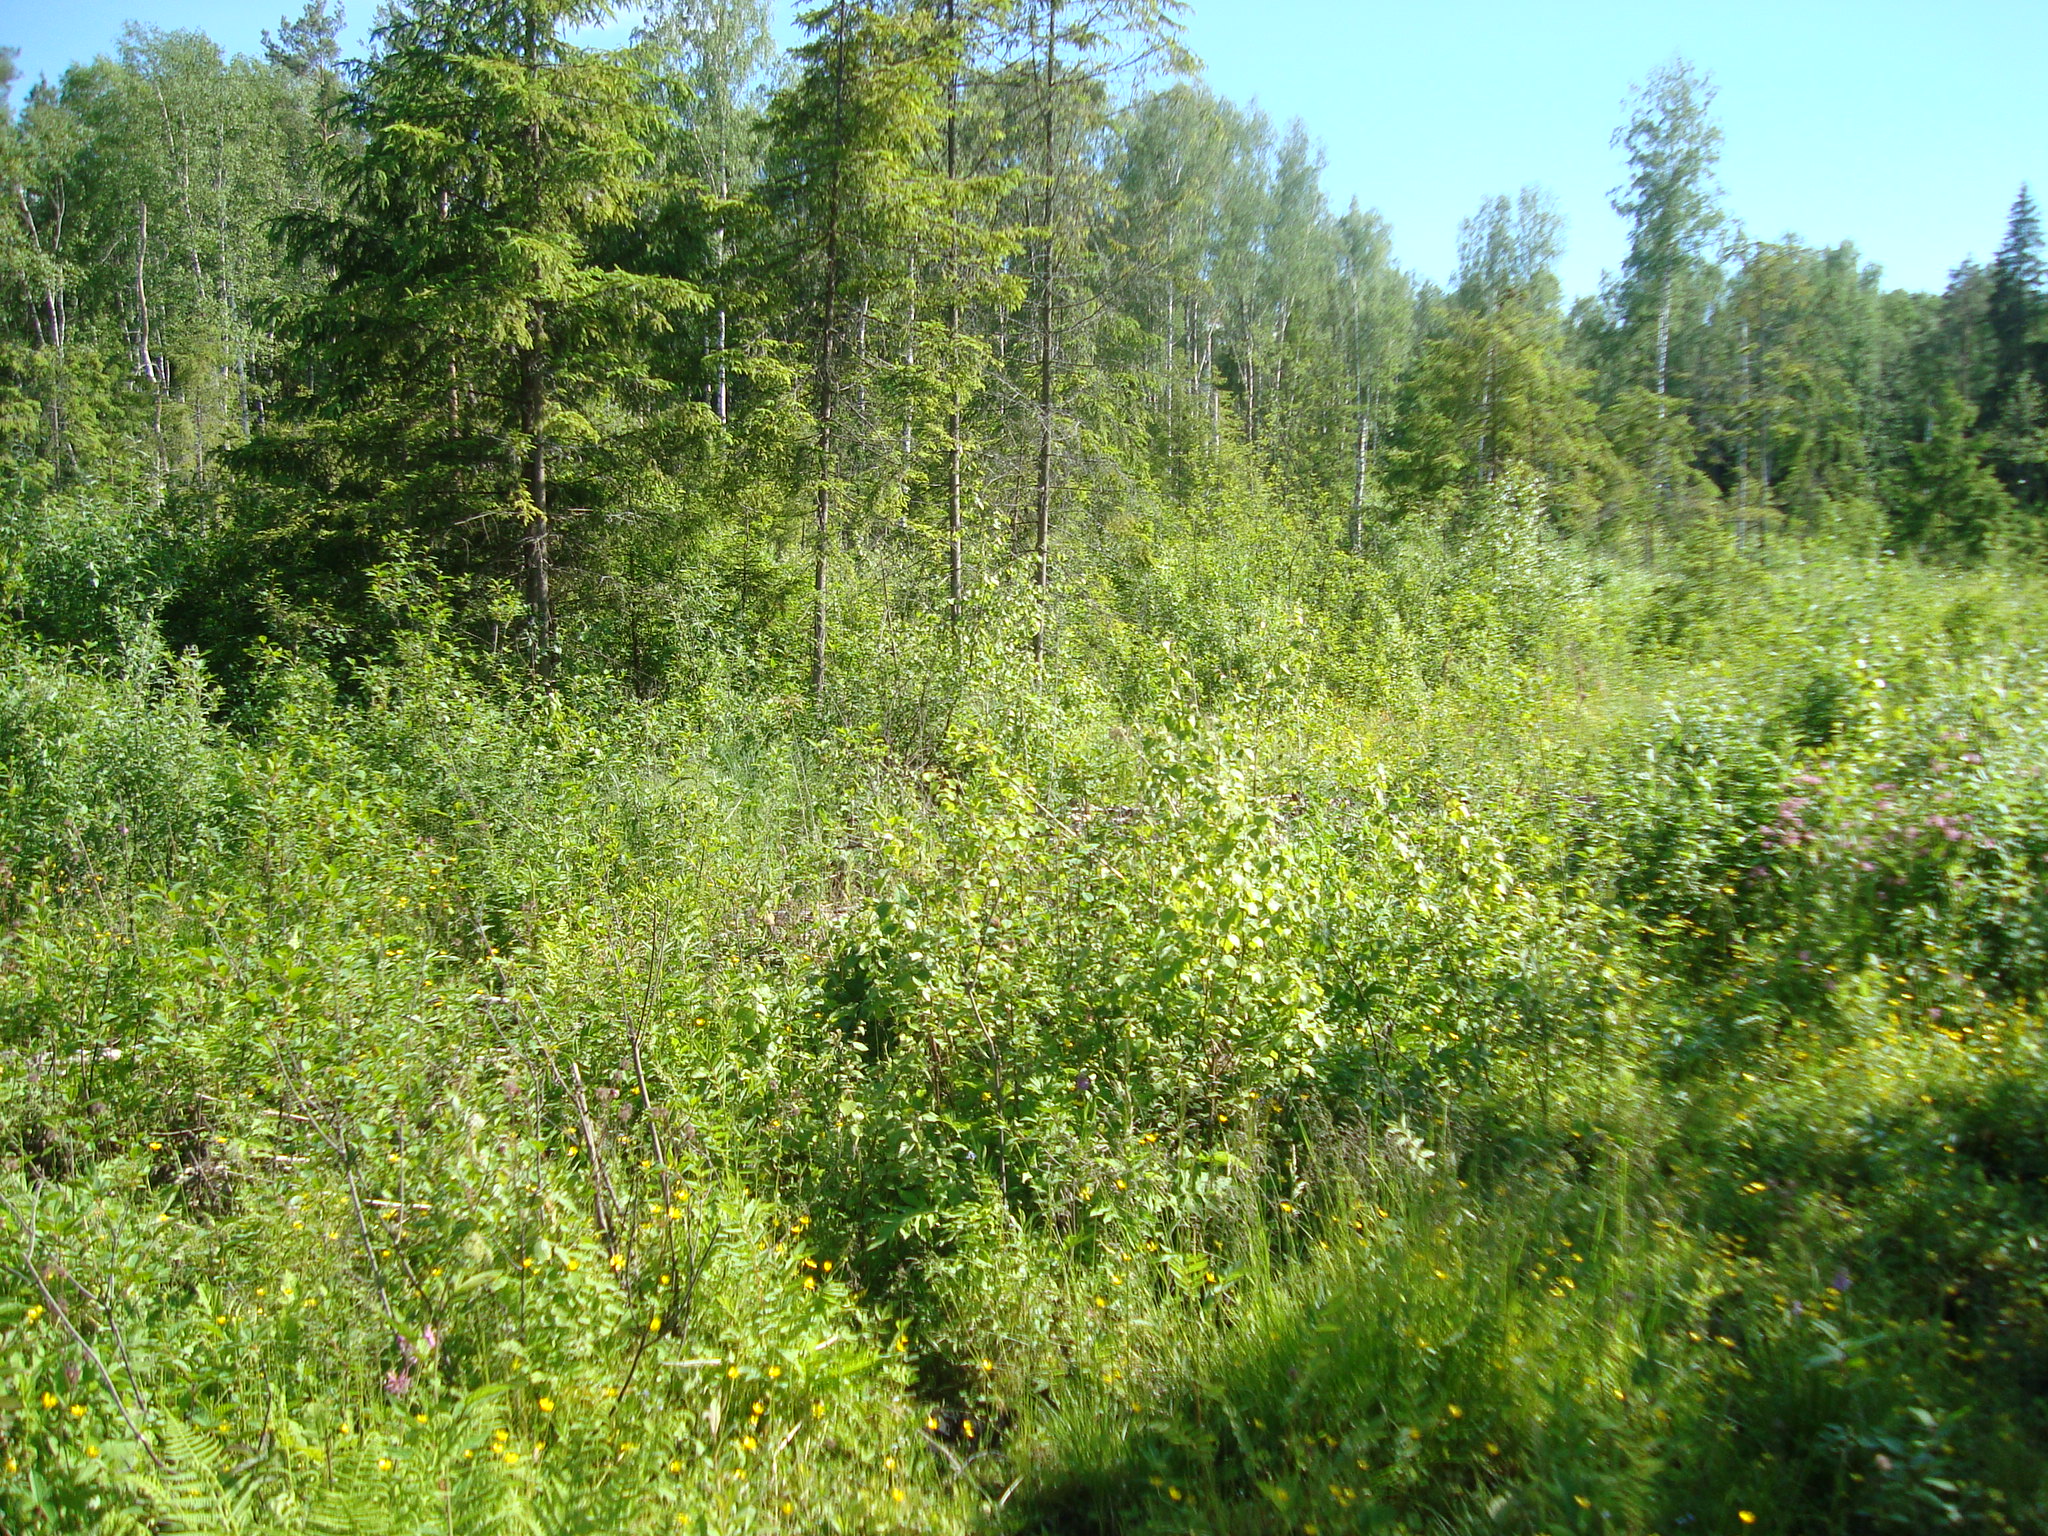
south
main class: Woodland
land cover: Spruce dominated mixed woodland
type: hemiboreal forest and nemoral coniferous forest and mixed broadleaved-coniferous forest
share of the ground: > 75 %
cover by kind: broadleaved forest trees 50 %, coniferous forest trees 30 %, shrubs 15 %, herbaceous plants 5 %
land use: Forestry
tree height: < 5 m
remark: Clear cut
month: June
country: LV
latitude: 56.6585
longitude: 25.7377
